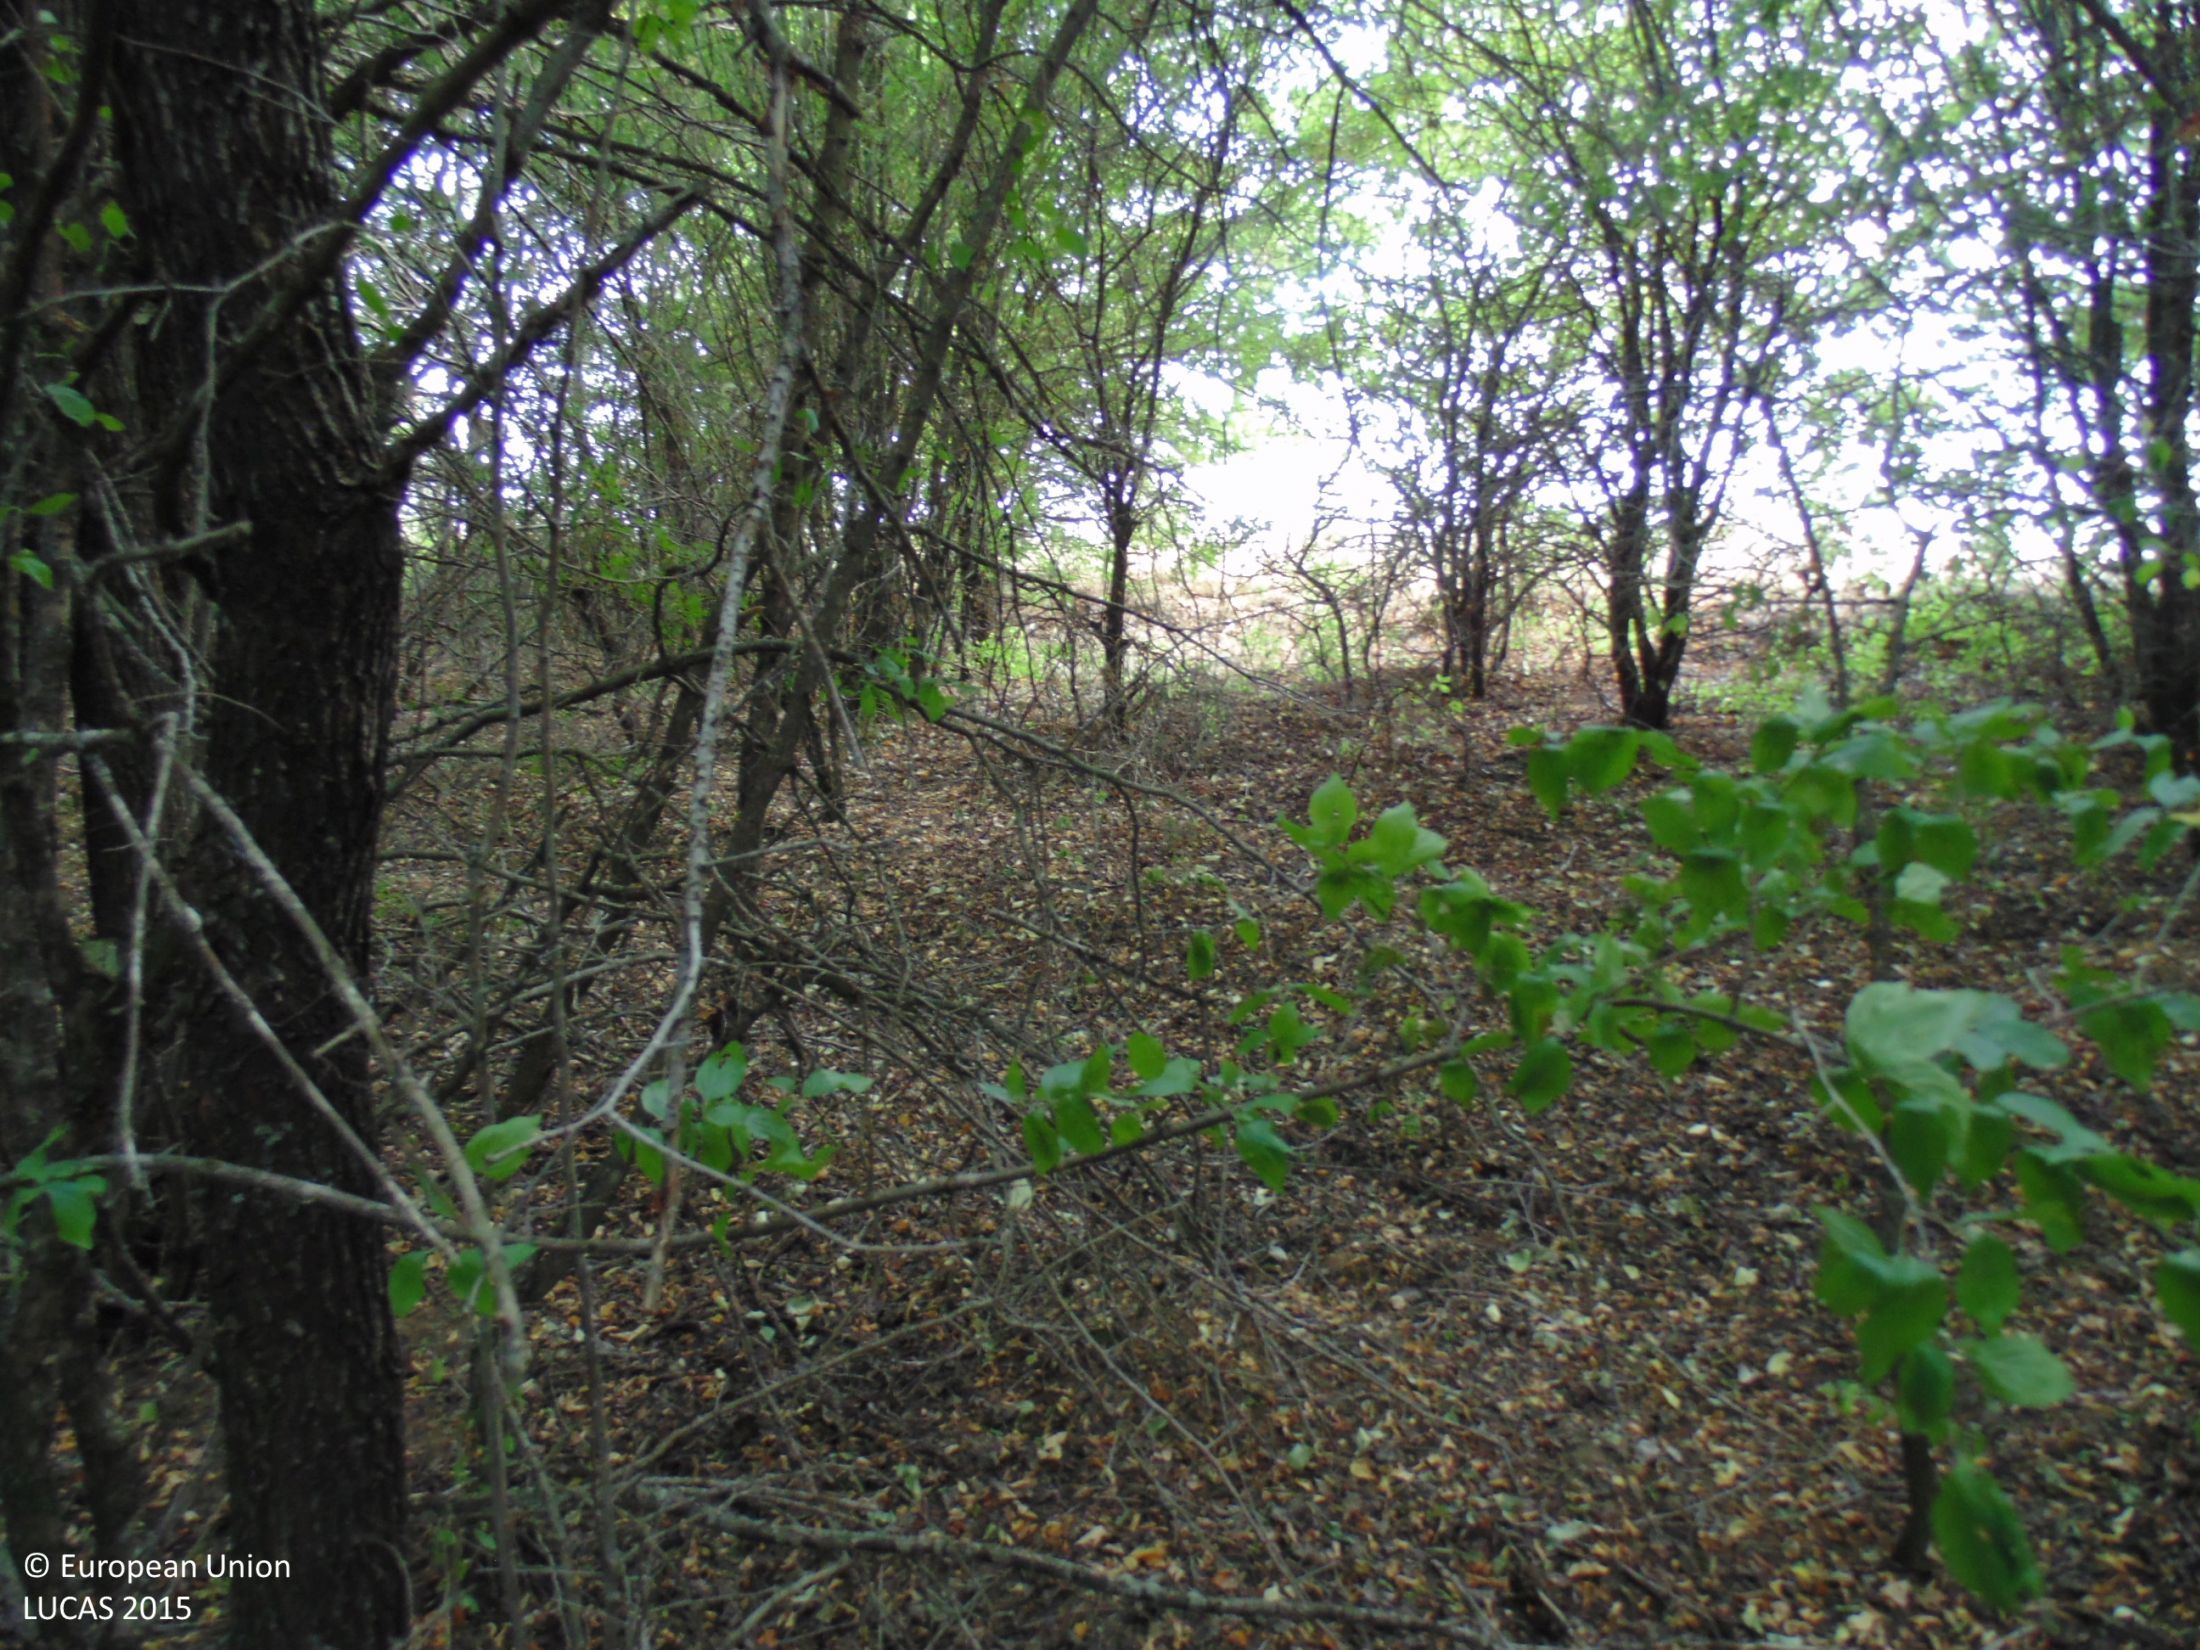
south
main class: Woodland
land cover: Broadleaved woodland
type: mesophytic deciduous forest
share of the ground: > 75 %
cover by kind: broadleaved forest trees 95 %, unconsolidated bare surface 5 %
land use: Forestry
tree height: > 5 m
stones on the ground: < 10 %
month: August
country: BG
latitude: 43.9127
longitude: 27.6359
